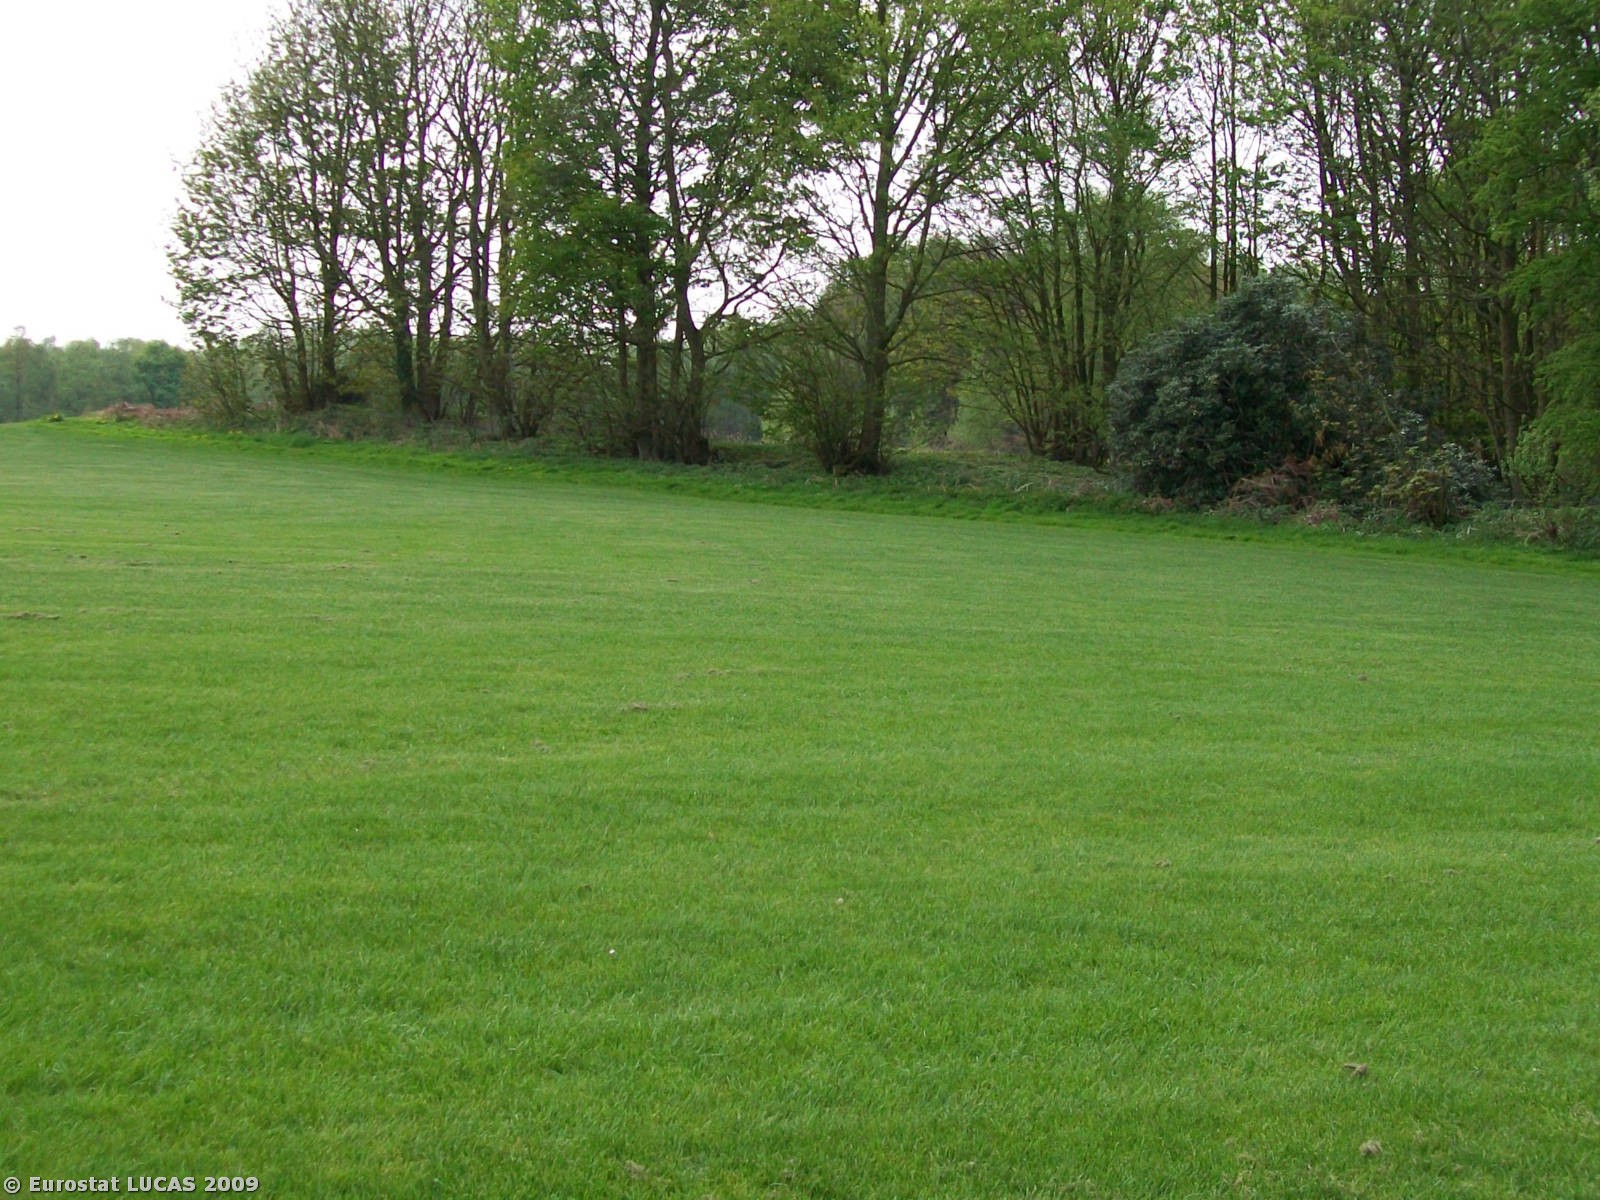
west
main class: Grassland
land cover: Grassland without tree/shrub cover
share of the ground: 50 - 75 %
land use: Agriculture (excluding fallow land and kitchen gardens)
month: April
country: GB
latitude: 53.5750
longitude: -2.8017
